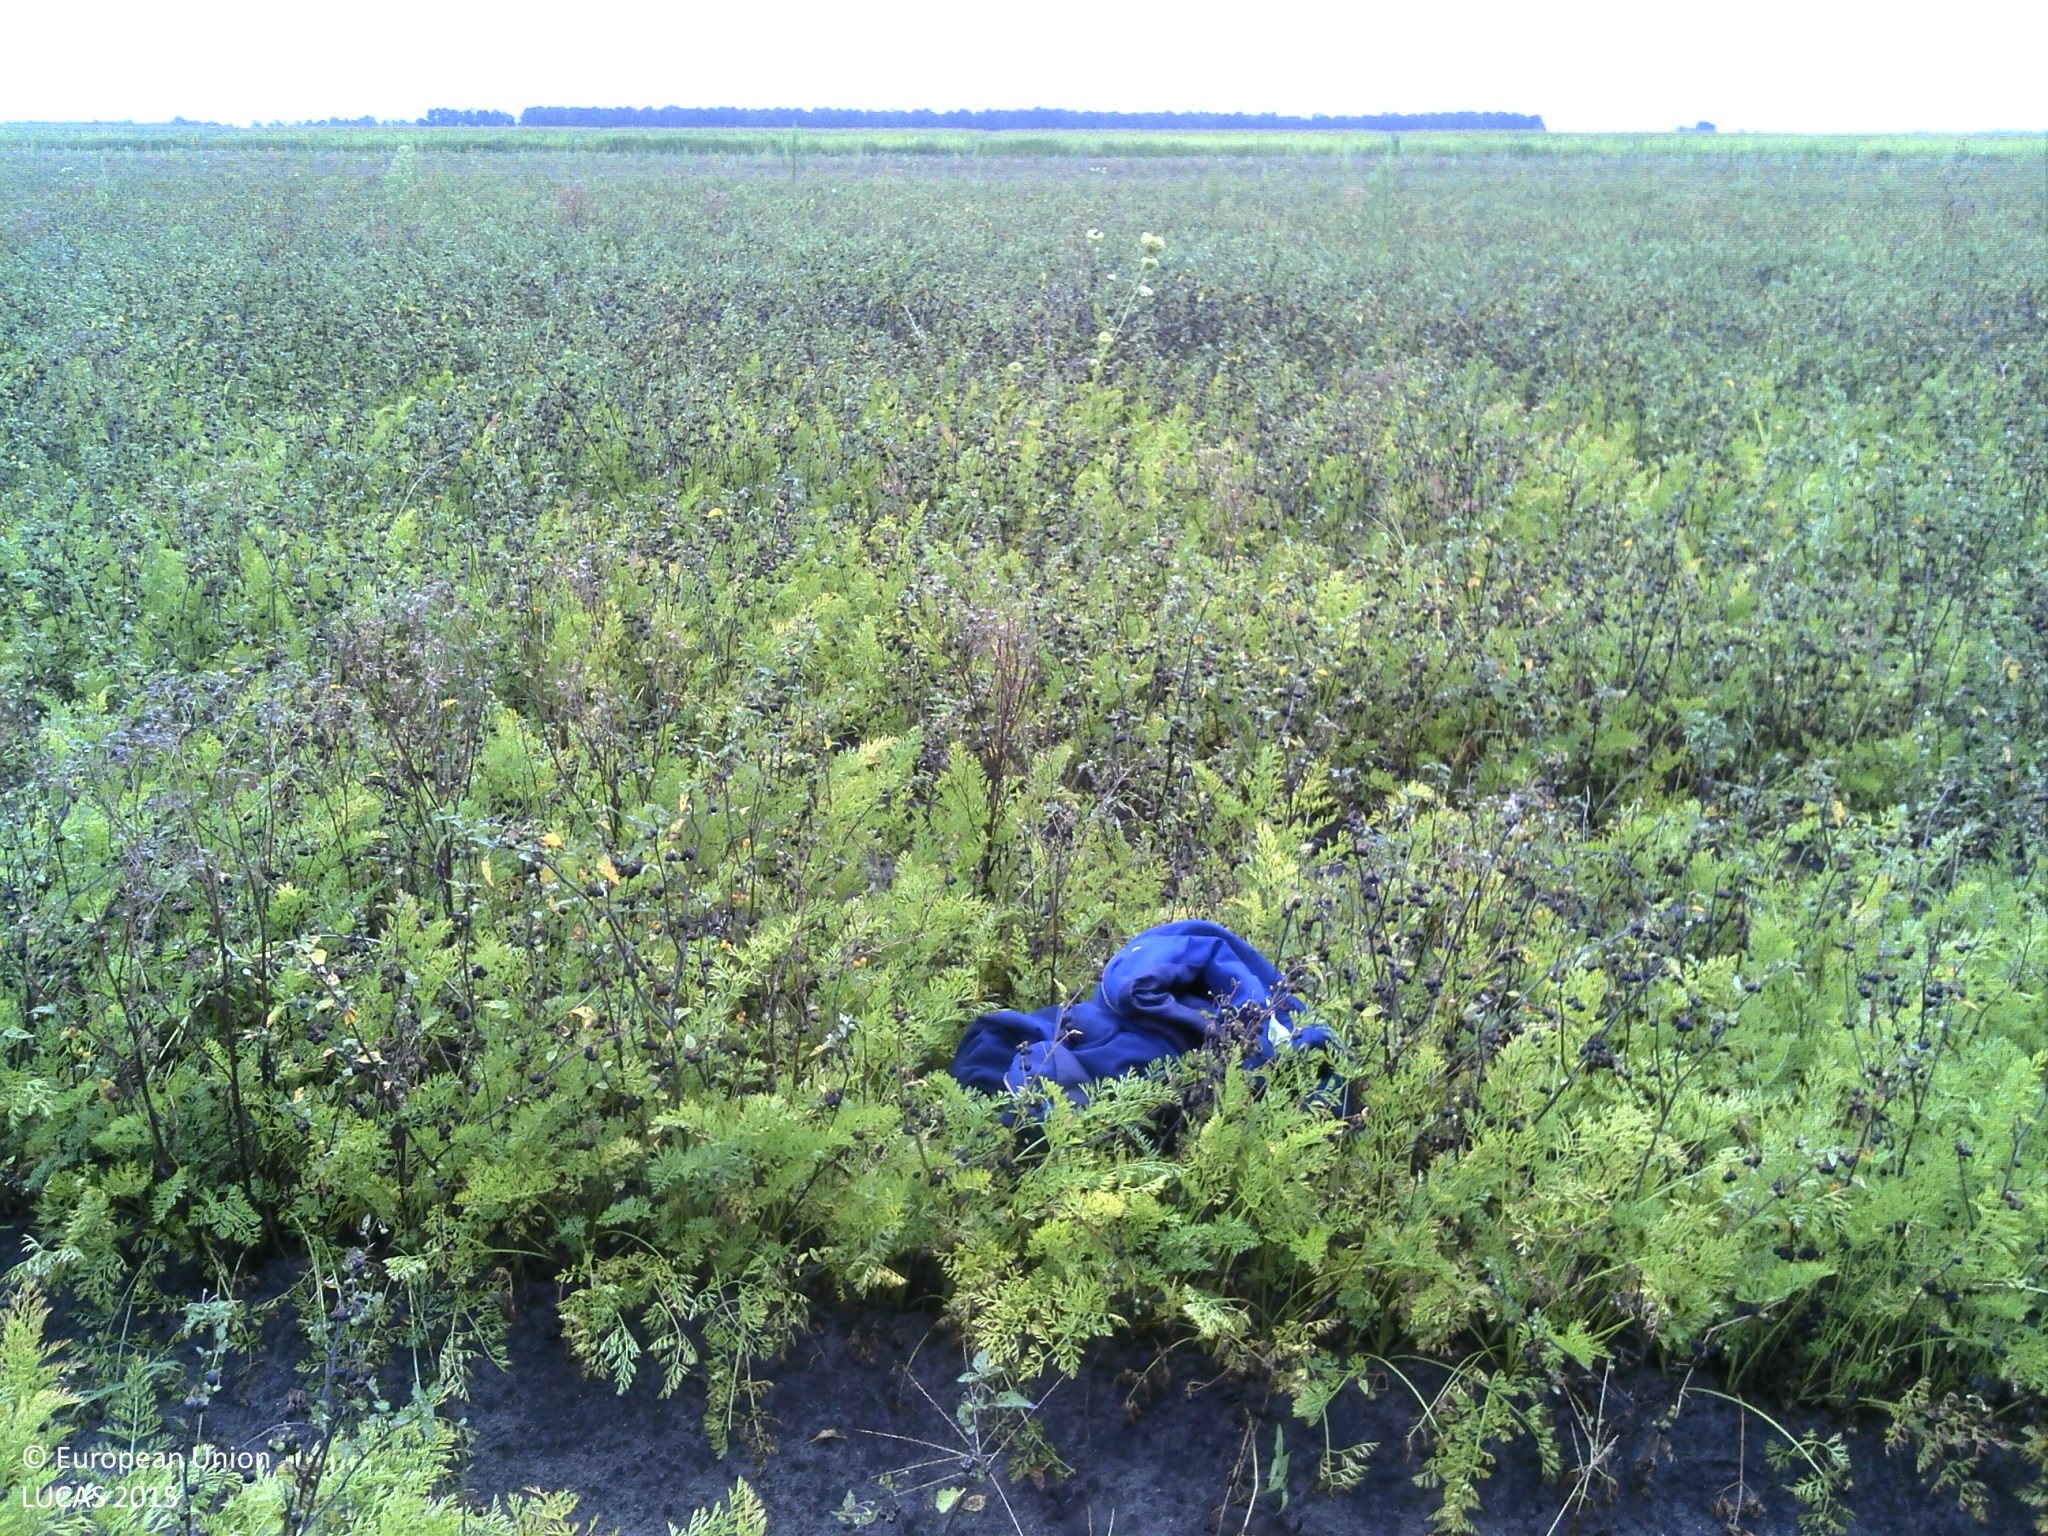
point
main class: Cropland
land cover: Other root crops
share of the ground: > 75 %
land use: Agriculture (excluding fallow land and kitchen gardens)
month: August
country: FR
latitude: 44.4487
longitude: -0.8887
